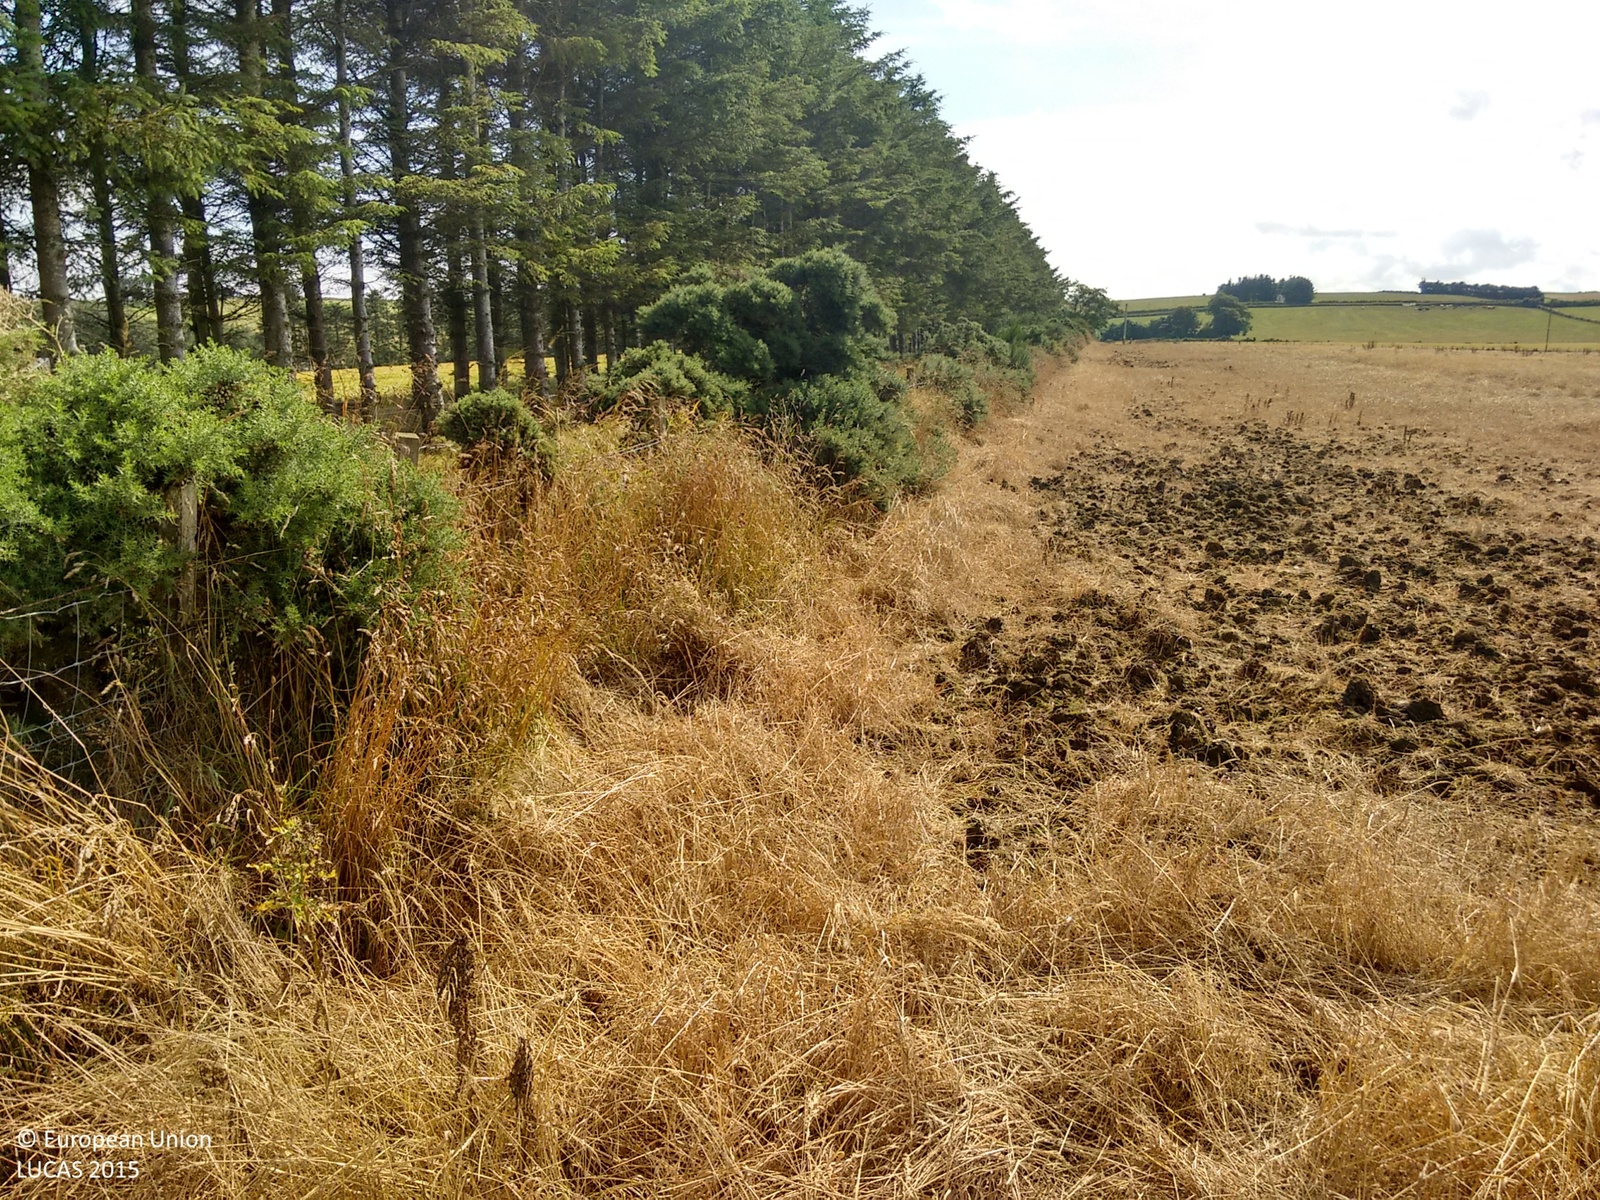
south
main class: Grassland
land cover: Grassland without tree/shrub cover
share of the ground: 50 - 75 %
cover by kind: herbaceous plants 75 %, unconsolidated bare surface 25 %
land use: Agriculture (excluding fallow land and kitchen gardens)
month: August
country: GB
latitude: 57.5491
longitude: -2.2296
